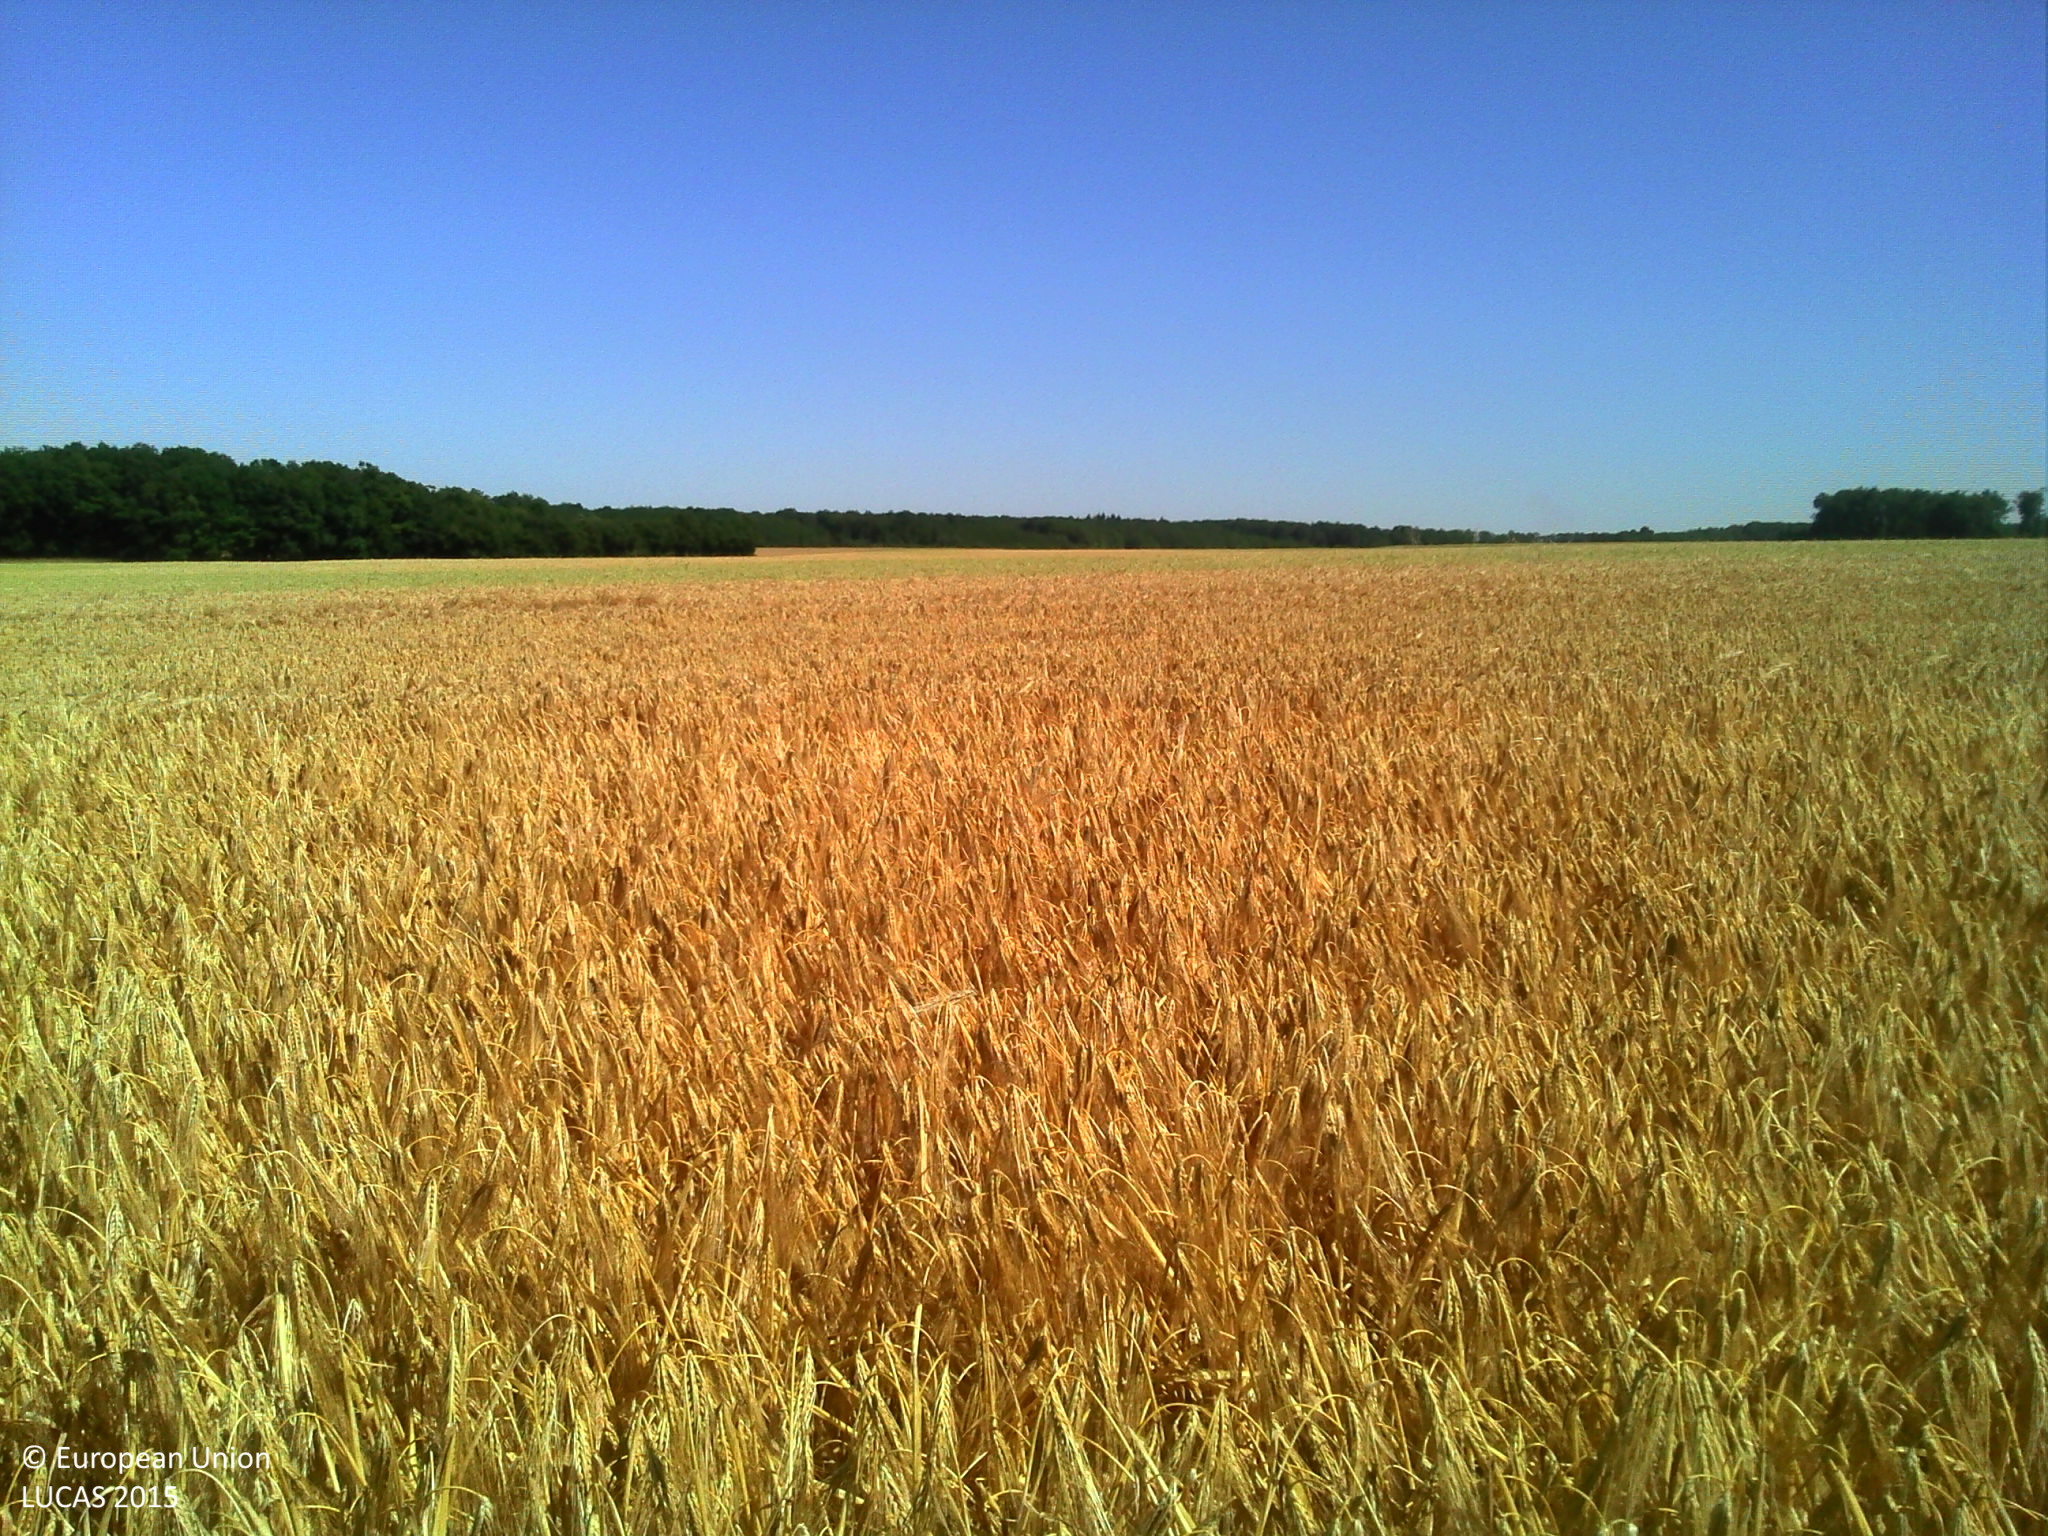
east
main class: Cropland
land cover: Barley
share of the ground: > 75 %
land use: Agriculture (excluding fallow land and kitchen gardens)
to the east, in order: Barley; Common wheat
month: June
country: FR
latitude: 48.9789
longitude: 1.2497
